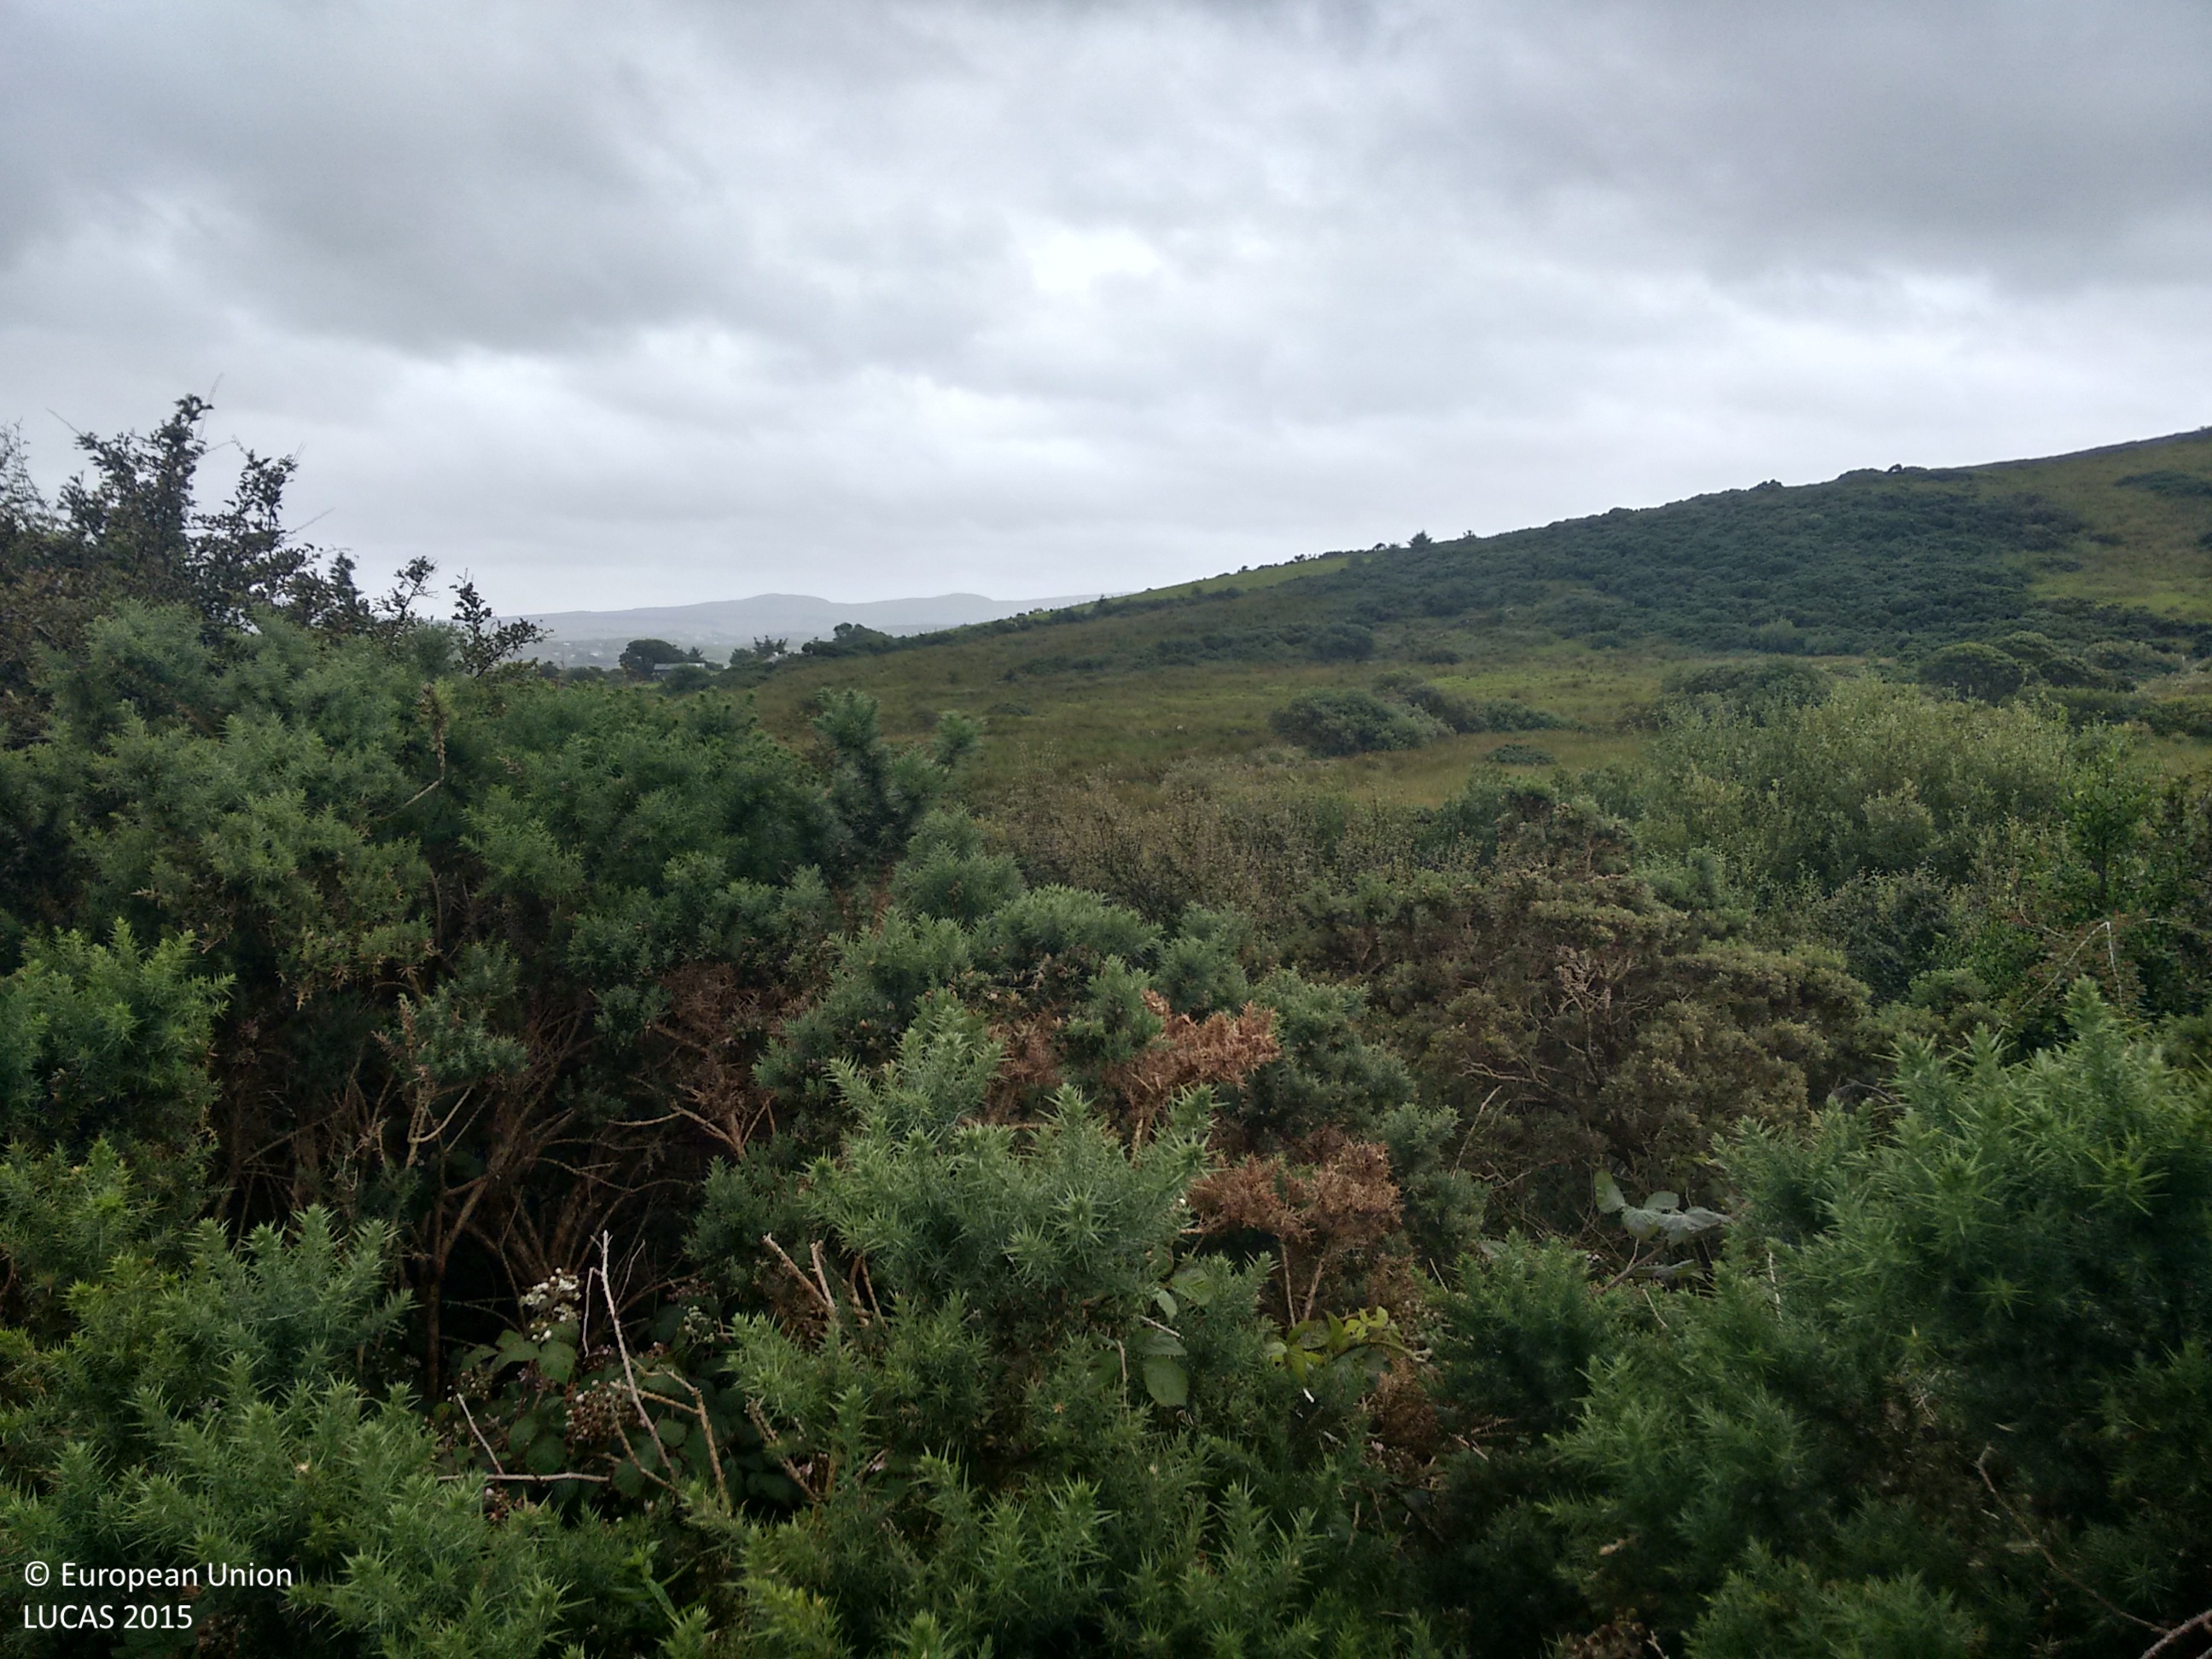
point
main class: Shrubland
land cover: Shrubland without tree cover
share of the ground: > 75 %
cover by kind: shrubs 60 %, herbaceous plants 40 %
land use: Agriculture (excluding fallow land and kitchen gardens)
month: August
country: IE
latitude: 53.5882
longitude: -9.9667
